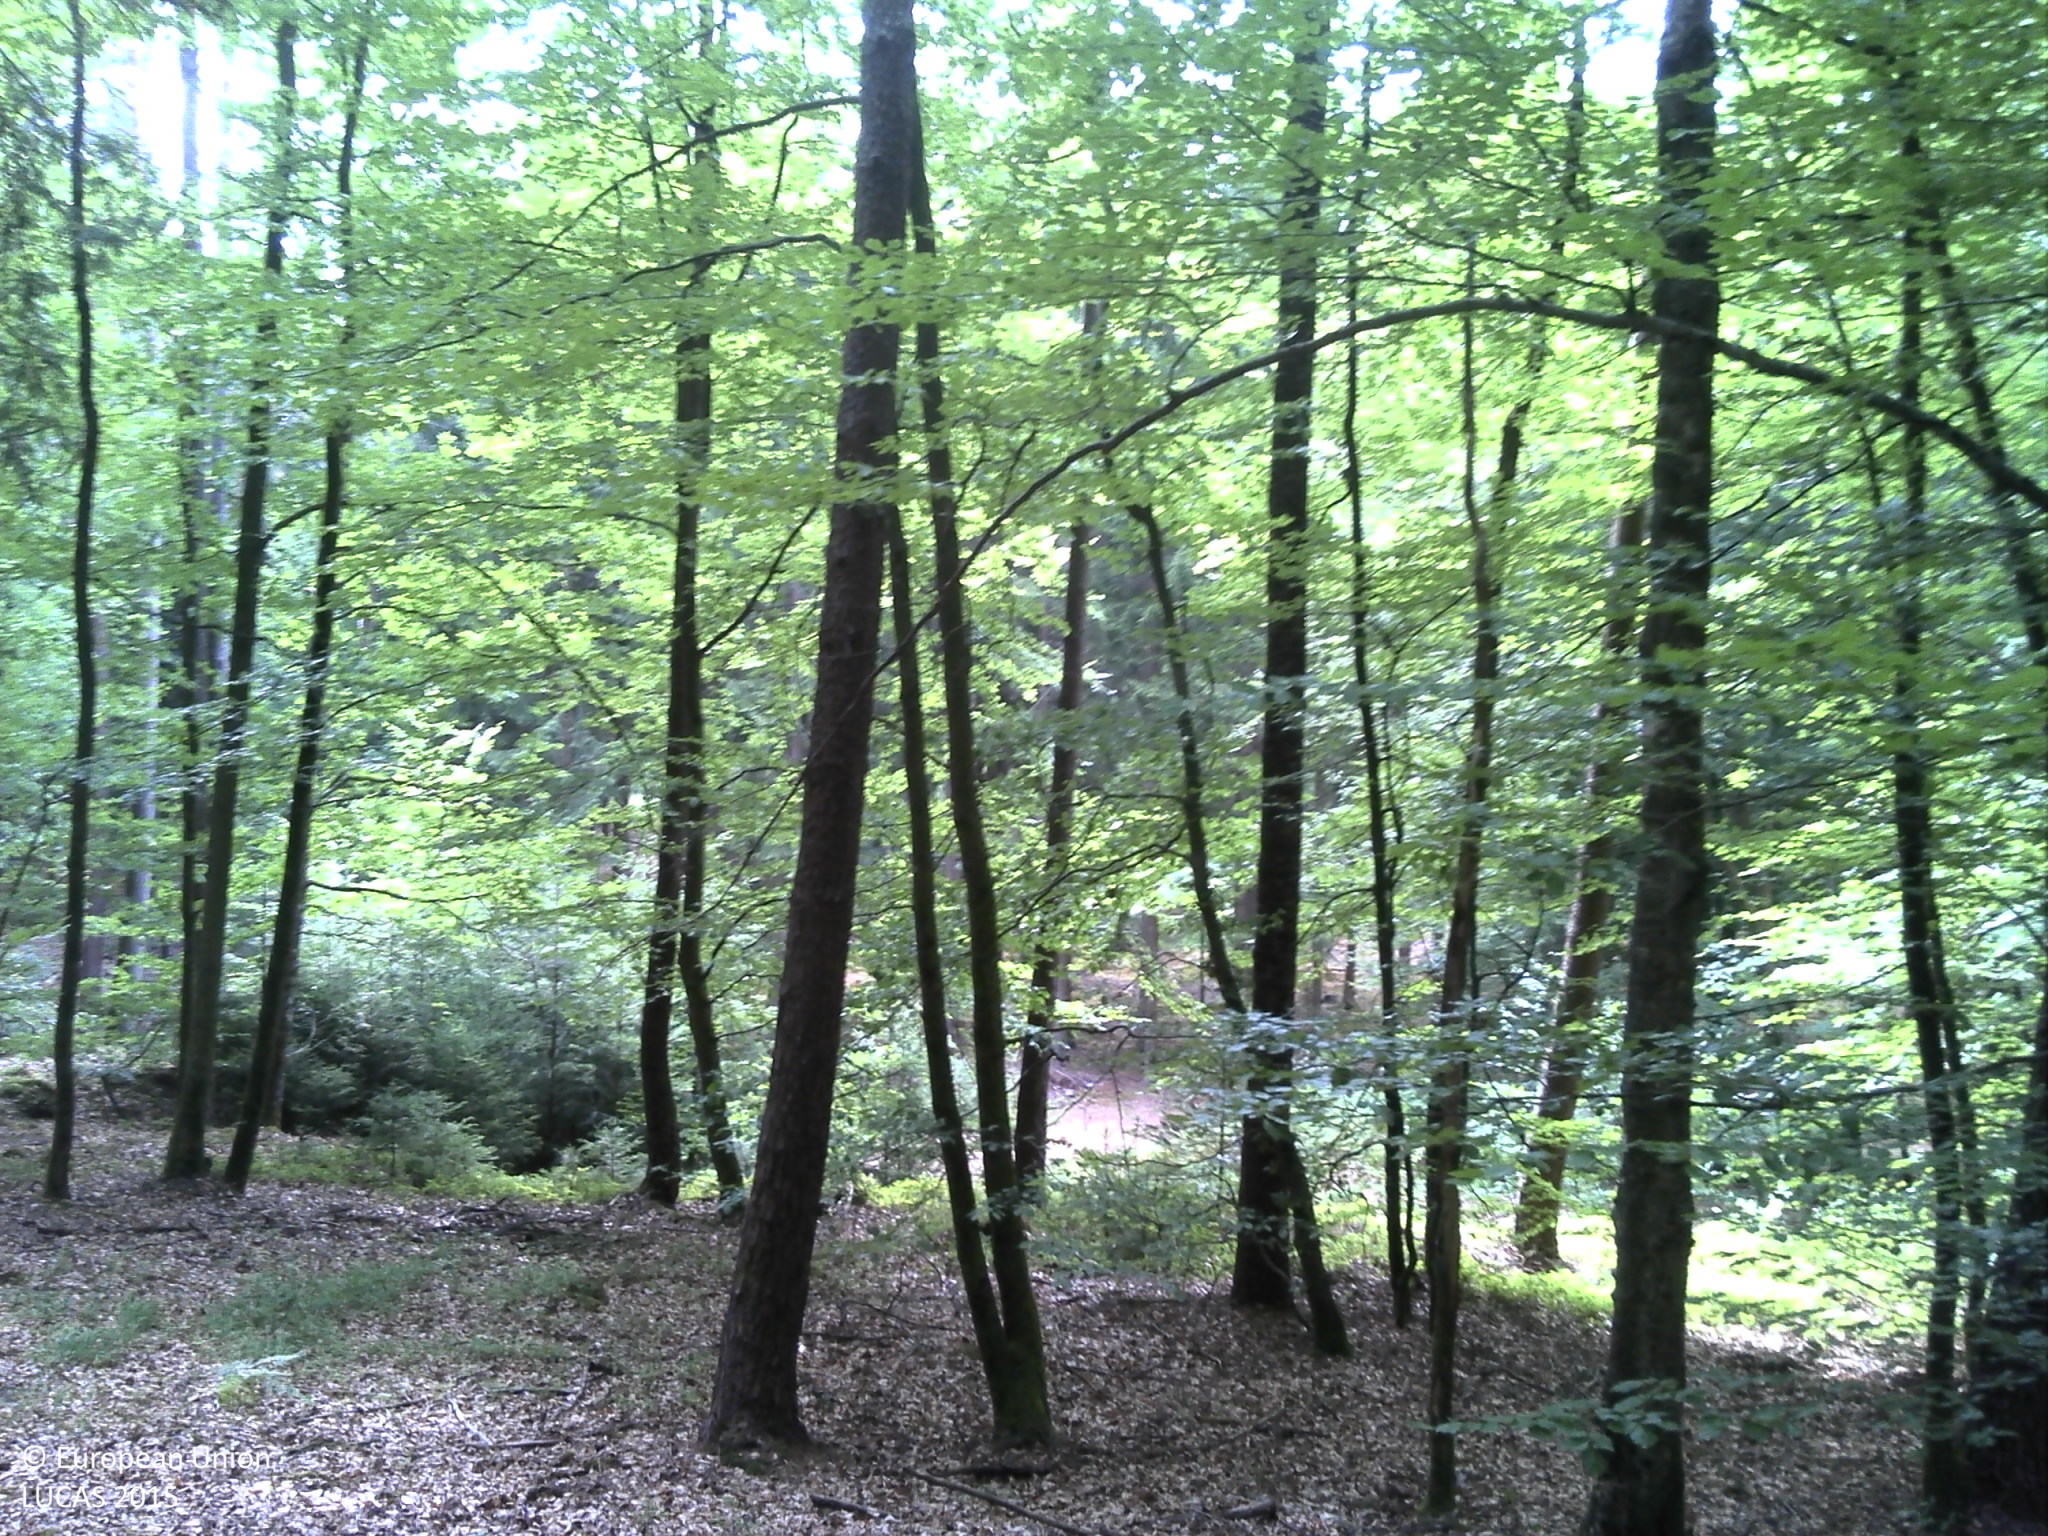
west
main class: Woodland
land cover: Pine dominated mixed woodland
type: hemiboreal forest and nemoral coniferous forest and mixed broadleaved-coniferous forest
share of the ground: > 75 %
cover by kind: broadleaved forest trees 60 %, coniferous forest trees 40 %
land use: Forestry
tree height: > 5 m
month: July
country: FR
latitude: 49.0226
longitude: 7.4707
